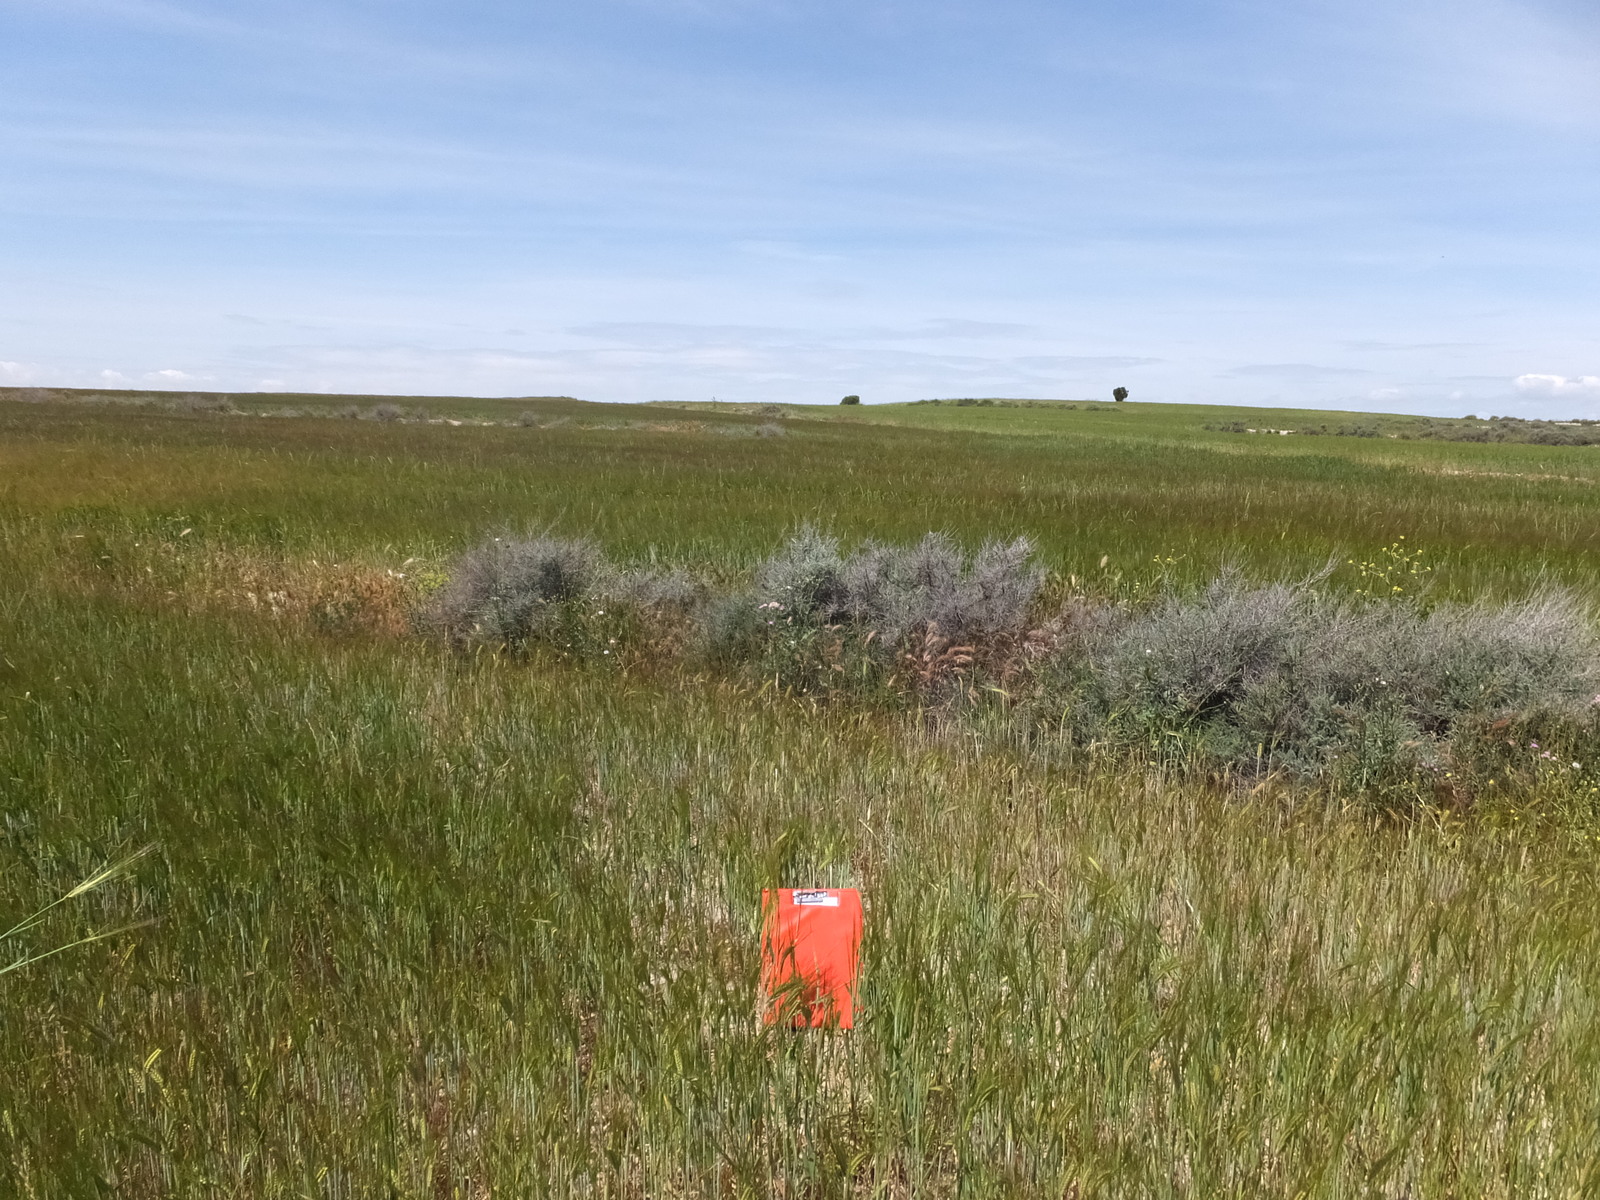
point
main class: Cropland
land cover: Barley
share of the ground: > 75 %
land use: Agriculture (excluding fallow land and kitchen gardens)
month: April
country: ES
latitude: 41.4975
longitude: -0.2340
